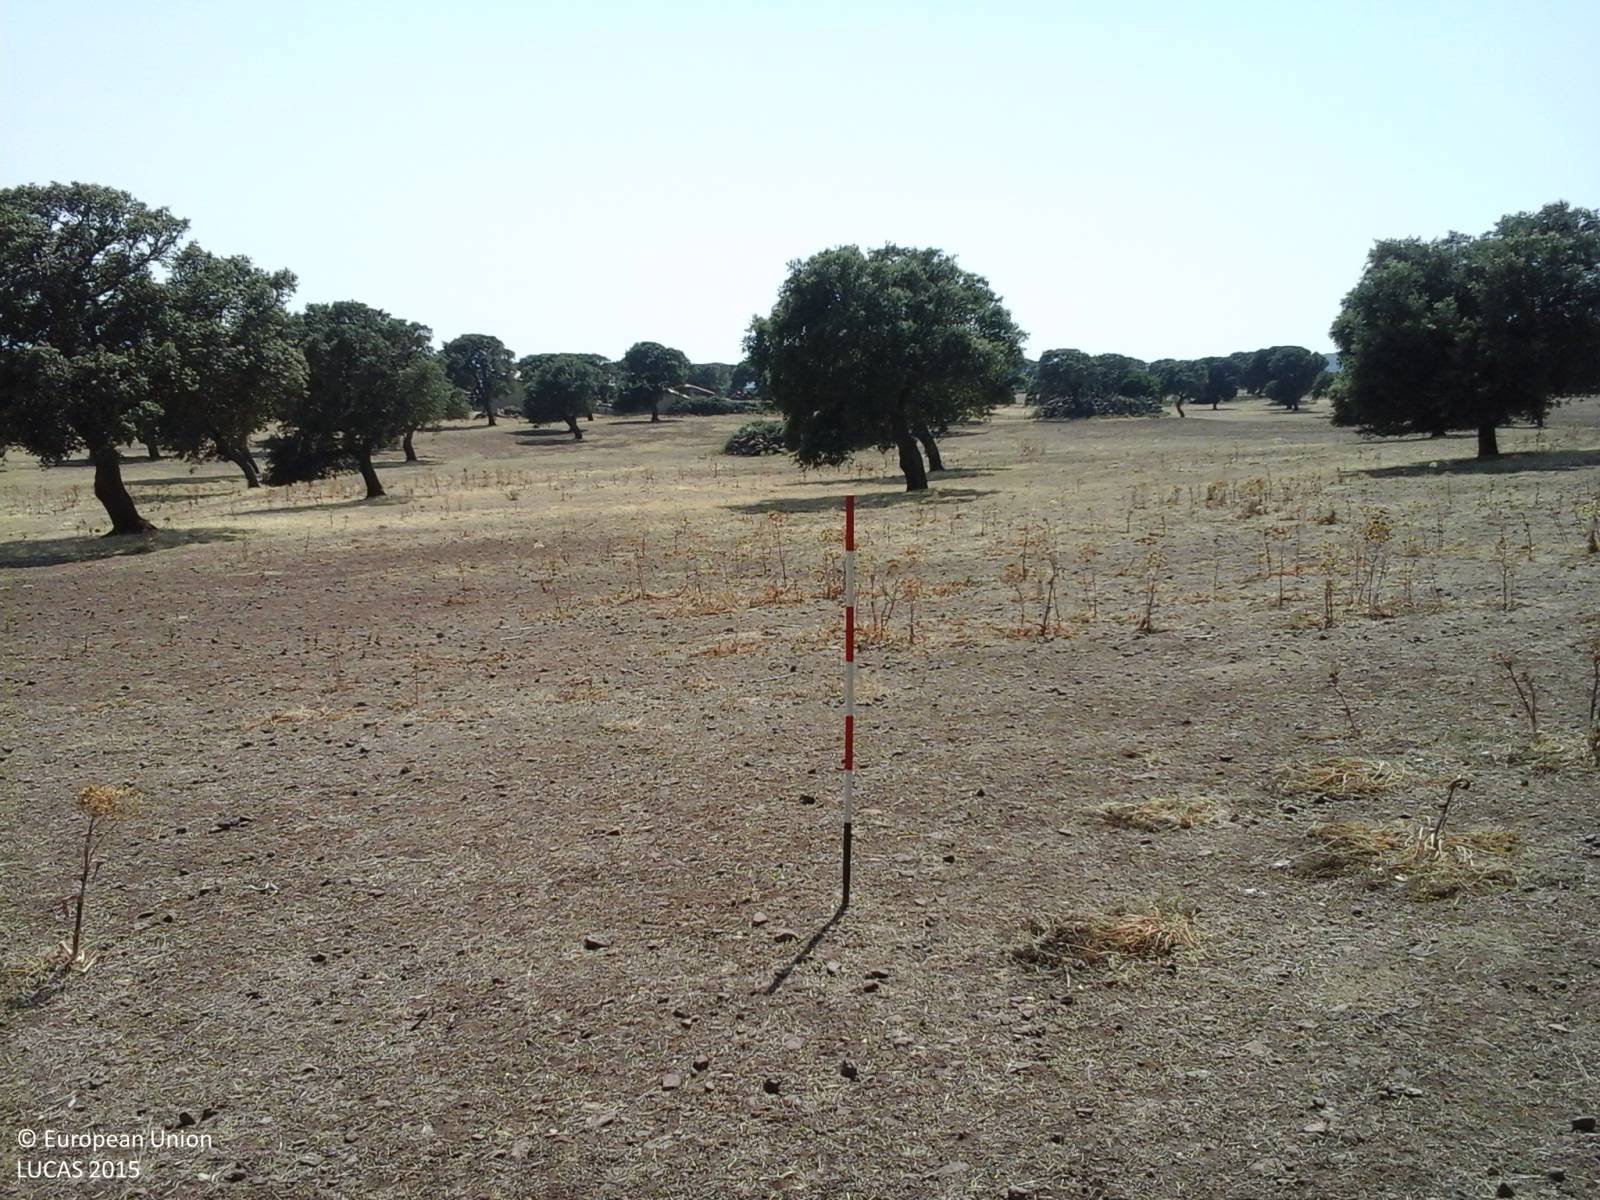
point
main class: Grassland
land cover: Grassland without tree/shrub cover
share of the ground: > 75 %
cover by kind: herbaceous plants 100 %
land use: Agriculture (excluding fallow land and kitchen gardens)
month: July
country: IT
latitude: 40.1130
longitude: 8.6346
